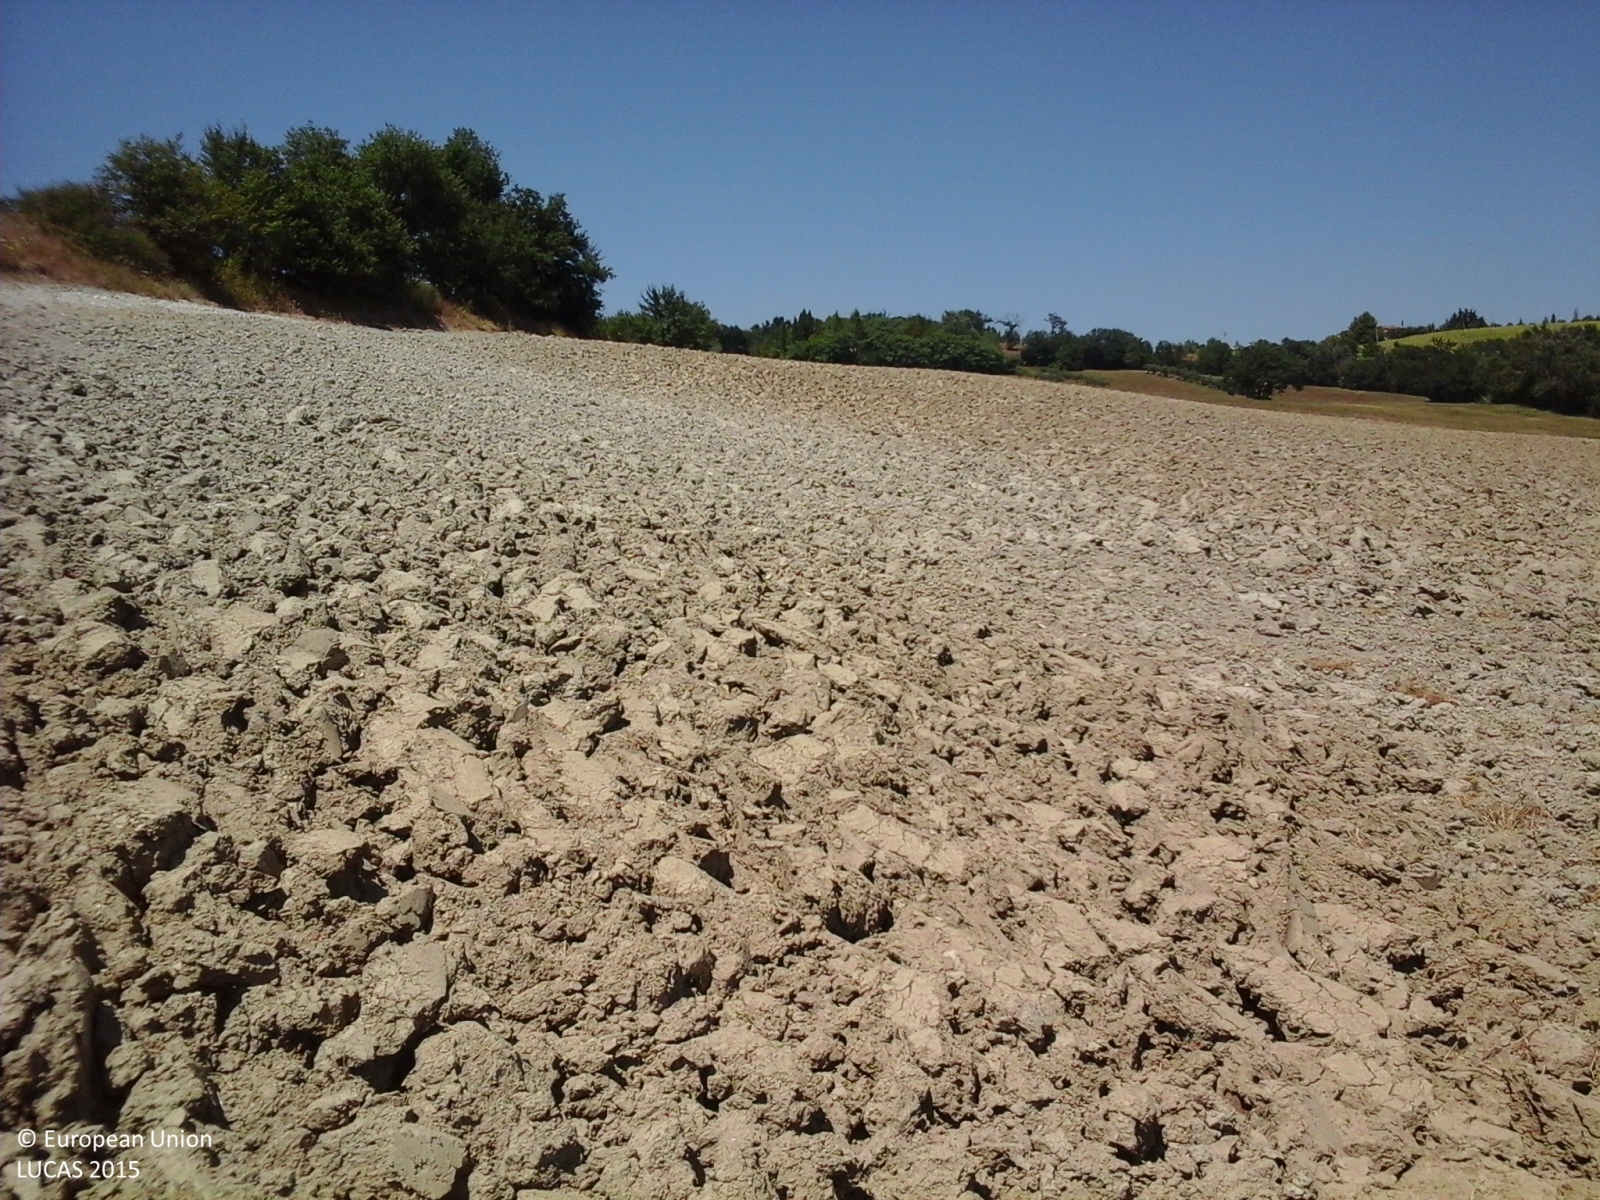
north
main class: Cropland
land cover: Durum wheat
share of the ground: > 75 %
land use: Agriculture (excluding fallow land and kitchen gardens)
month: August
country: IT
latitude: 43.1736
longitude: 13.4476
